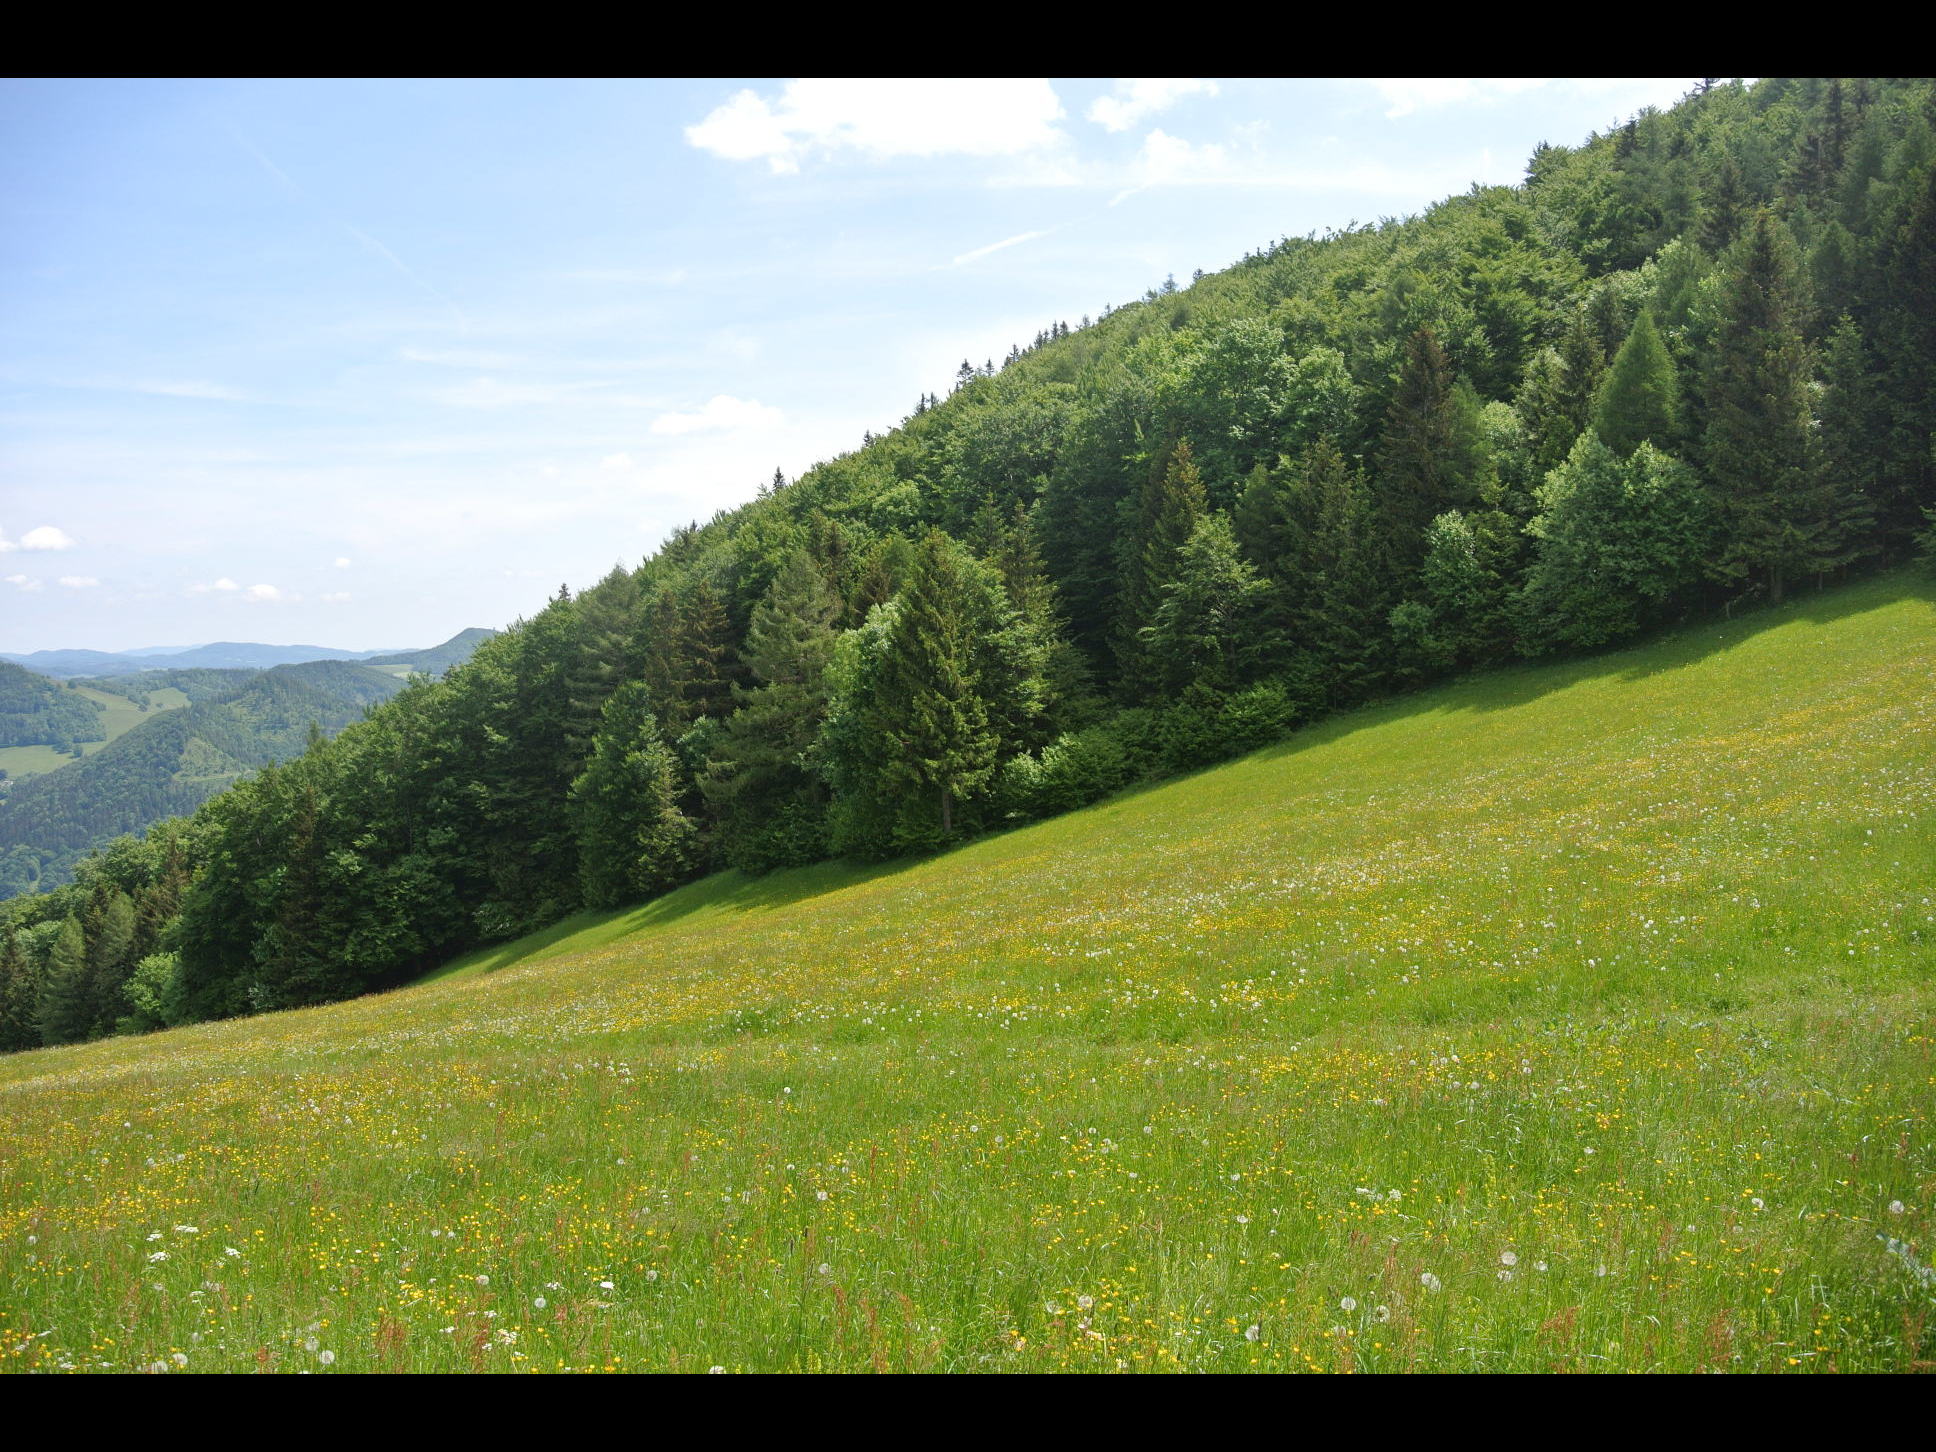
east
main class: Grassland
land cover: Grassland without tree/shrub cover
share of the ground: > 75 %
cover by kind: herbaceous plants 100 %
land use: Agriculture (excluding fallow land and kitchen gardens)
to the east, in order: Electric lines; Grassland without tree/shrub cover; Artificial constructions; Grassland without tree/shrub cover; Spruce dominated mixed woodland; Broadleaved woodland
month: May
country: AT
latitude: 47.9998
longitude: 15.7792
